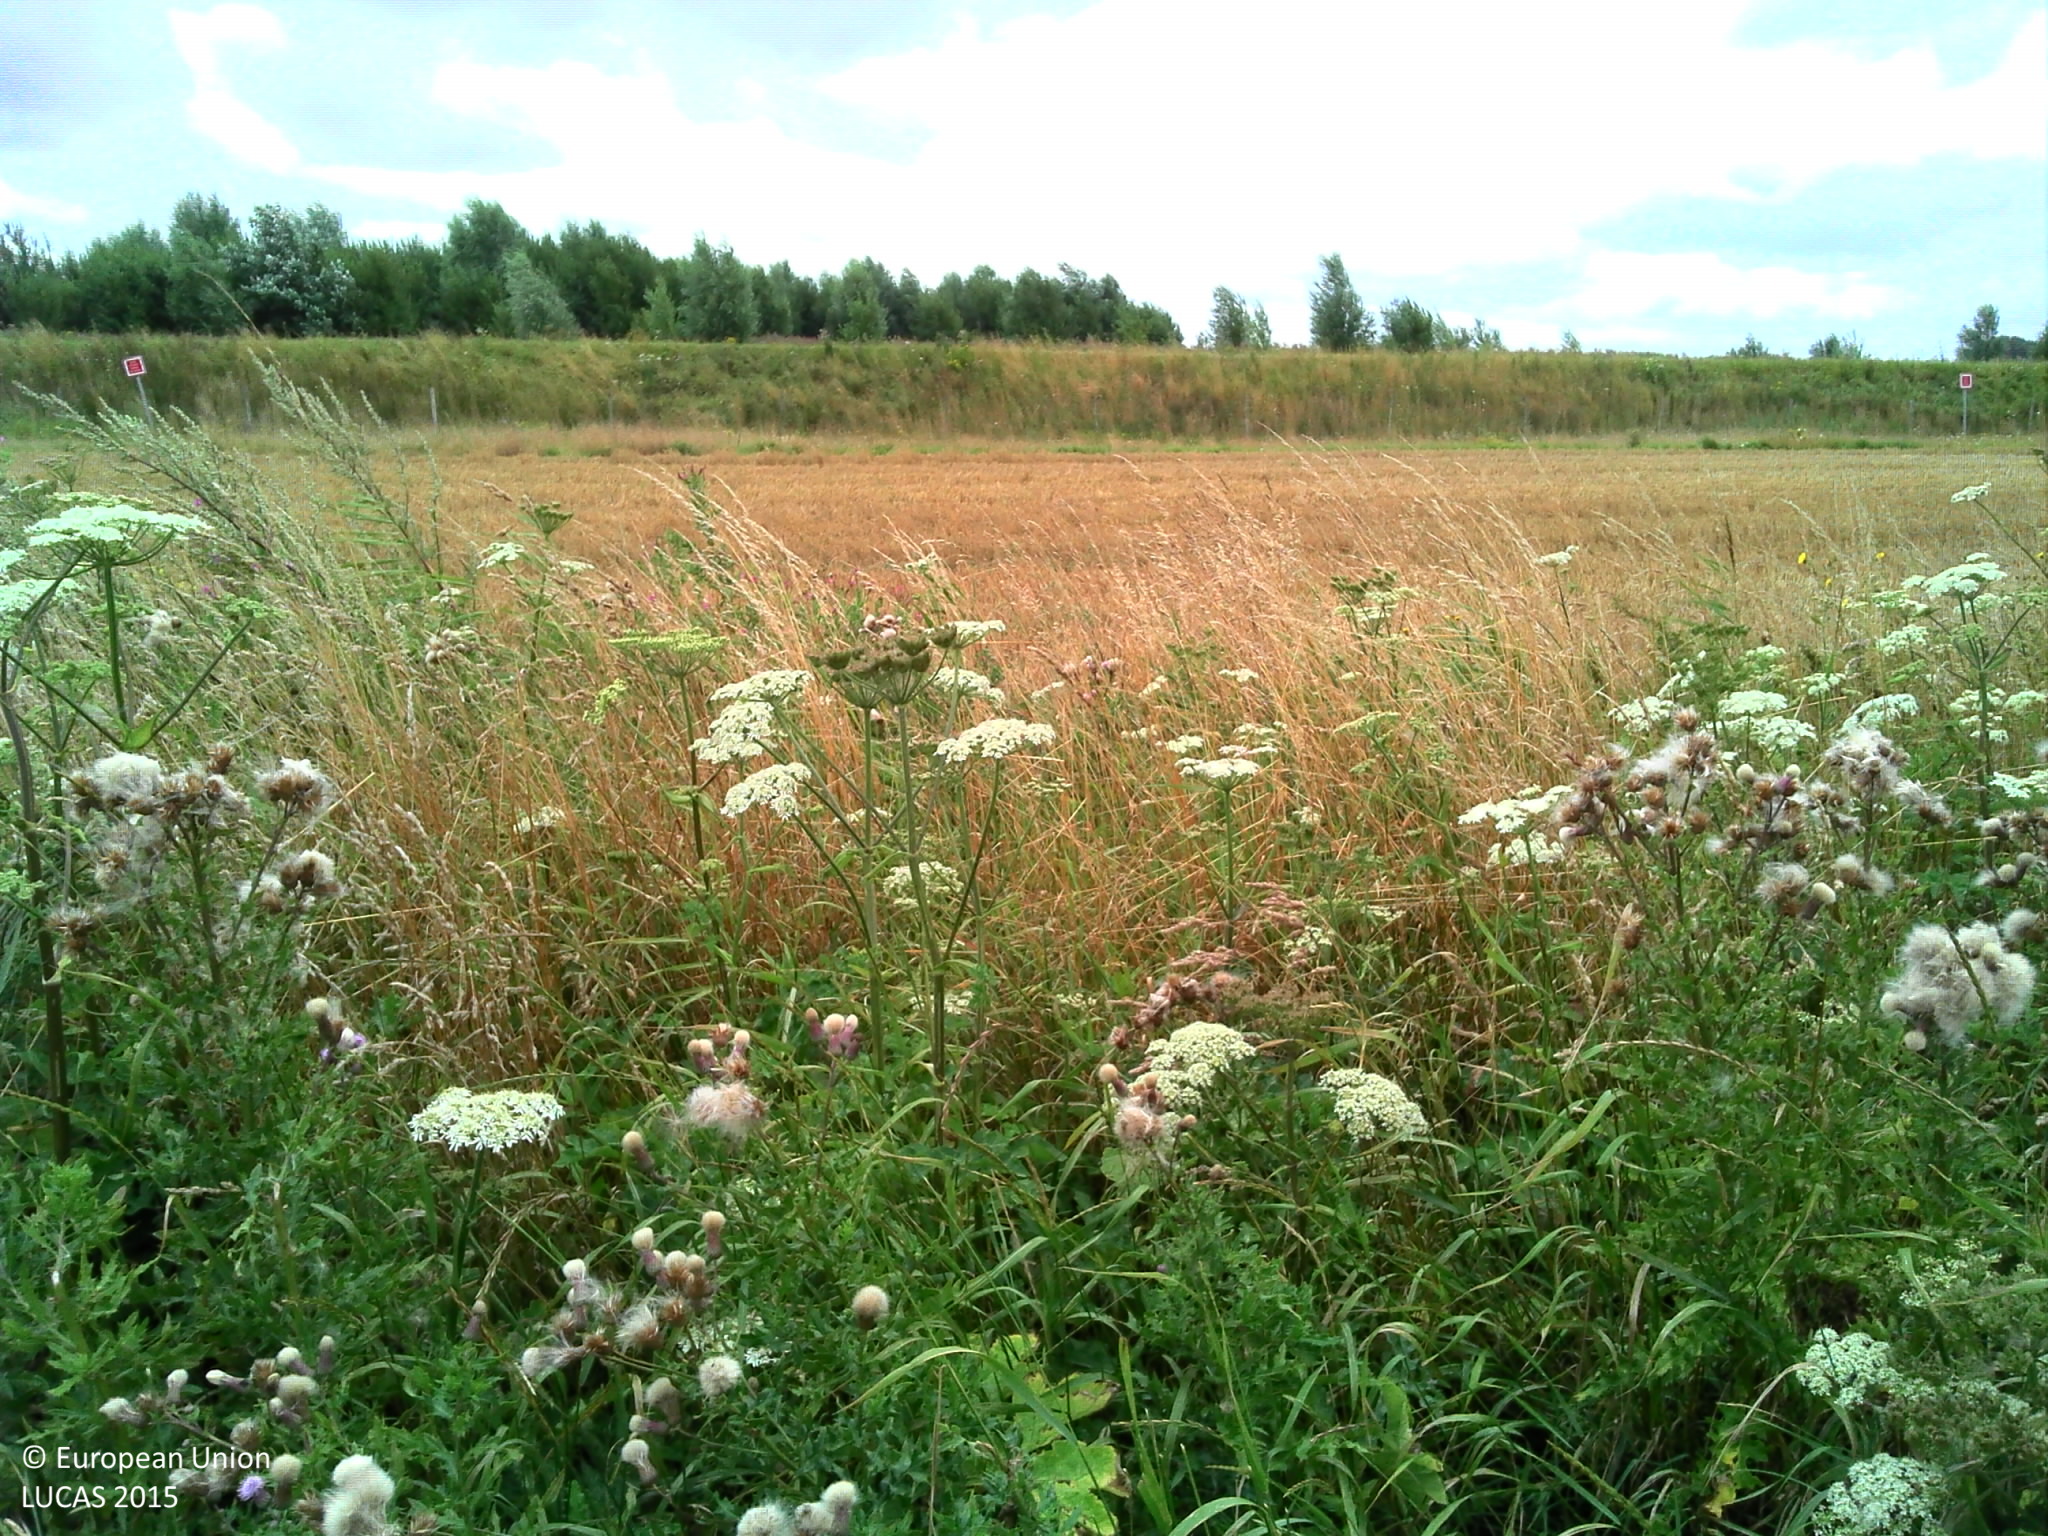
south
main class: Cropland
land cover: Rape and turnip rape
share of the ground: 10 - 25 %
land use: Agriculture (excluding fallow land and kitchen gardens)
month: August
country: FR
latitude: 50.9031
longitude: 2.0926
